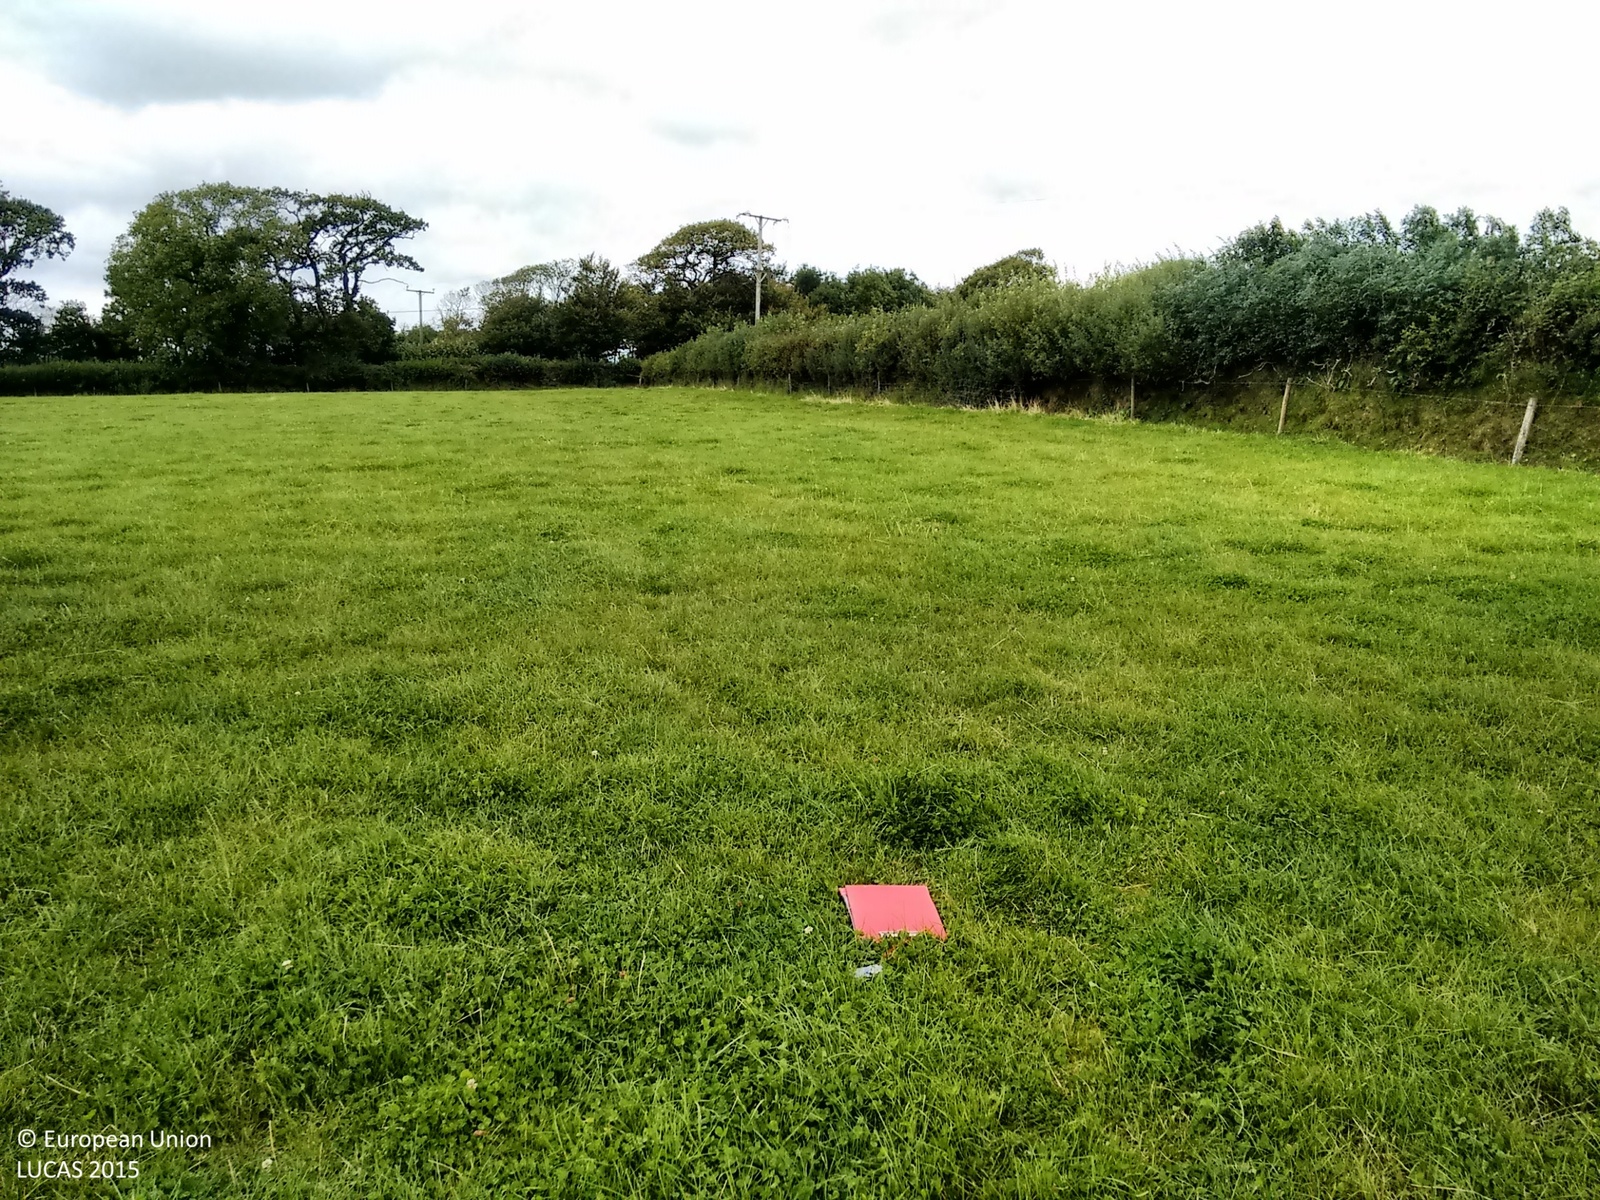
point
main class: Grassland
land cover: Grassland without tree/shrub cover
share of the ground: > 75 %
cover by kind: herbaceous plants 100 %
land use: Agriculture (excluding fallow land and kitchen gardens)
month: September
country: GB
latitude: 50.9195
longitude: -4.3116
